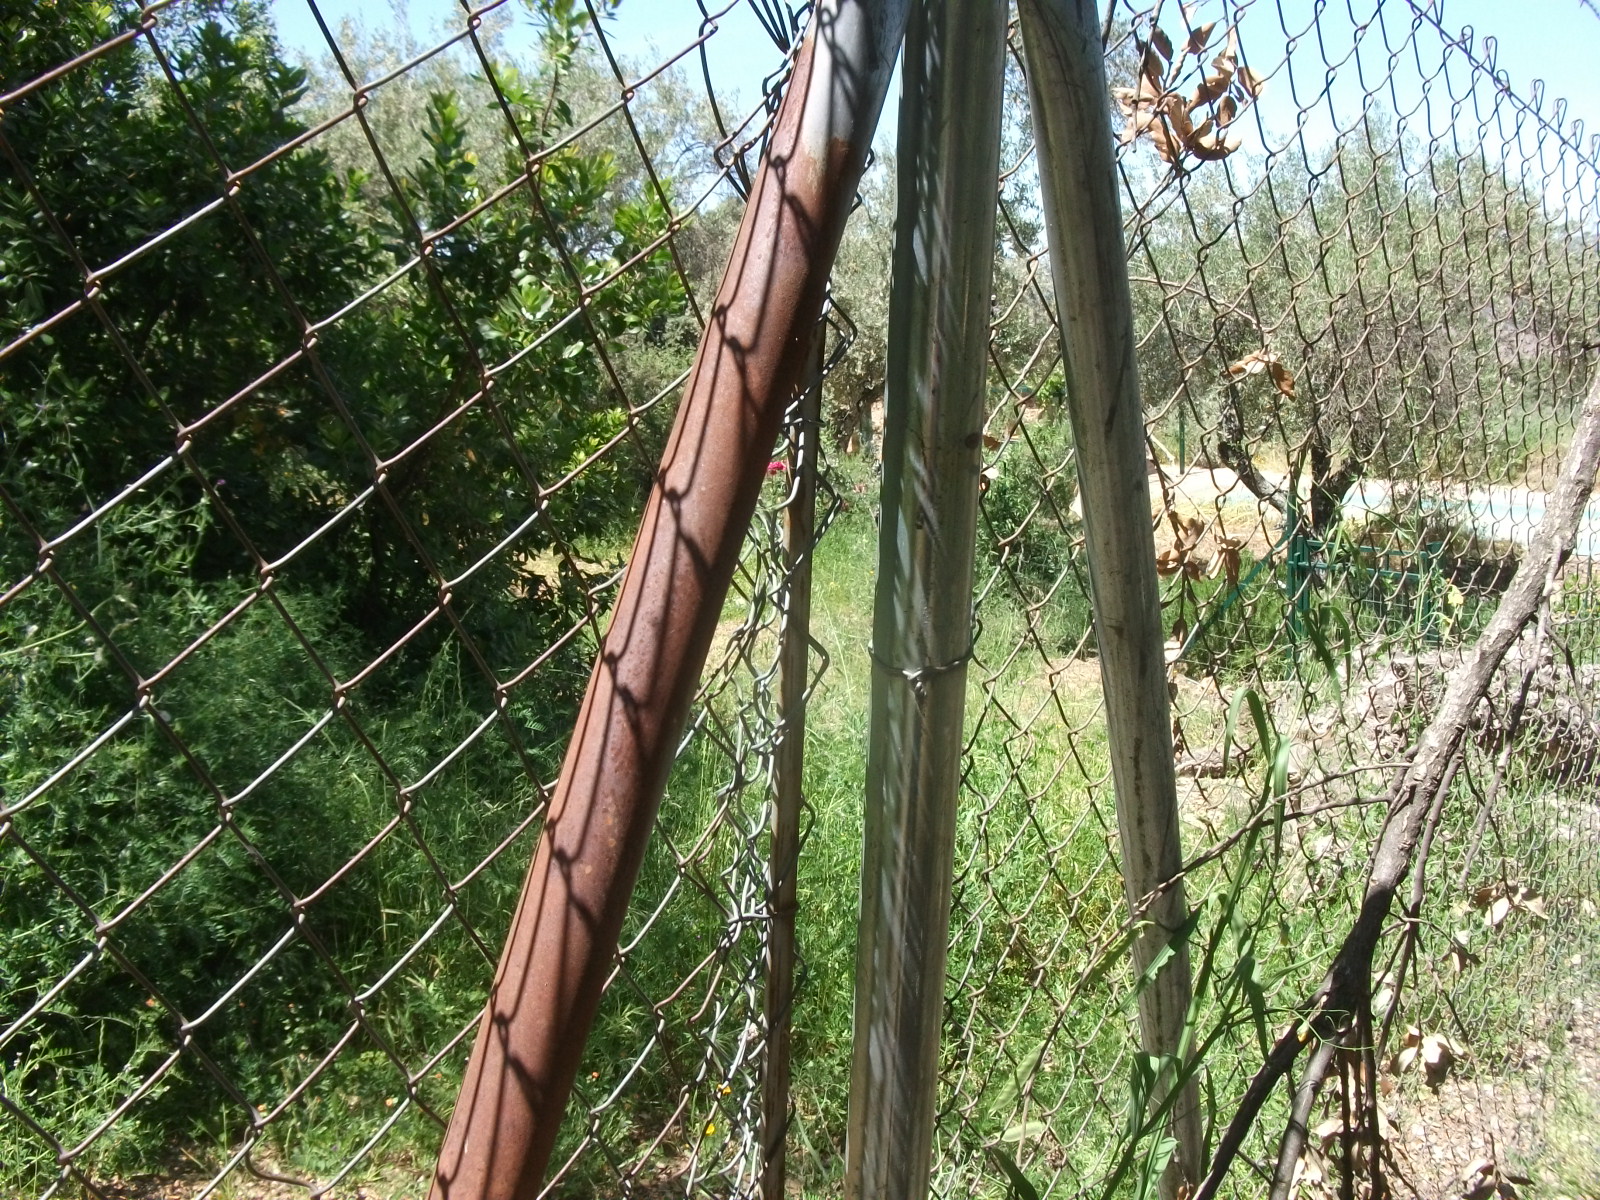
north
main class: Cropland
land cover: Olive groves
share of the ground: 10 - 25 %
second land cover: Spontaneously vegetated surfaces
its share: > 75 %
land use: Agriculture (excluding fallow land and kitchen gardens)
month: May
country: ES
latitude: 37.9346
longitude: -6.6228
